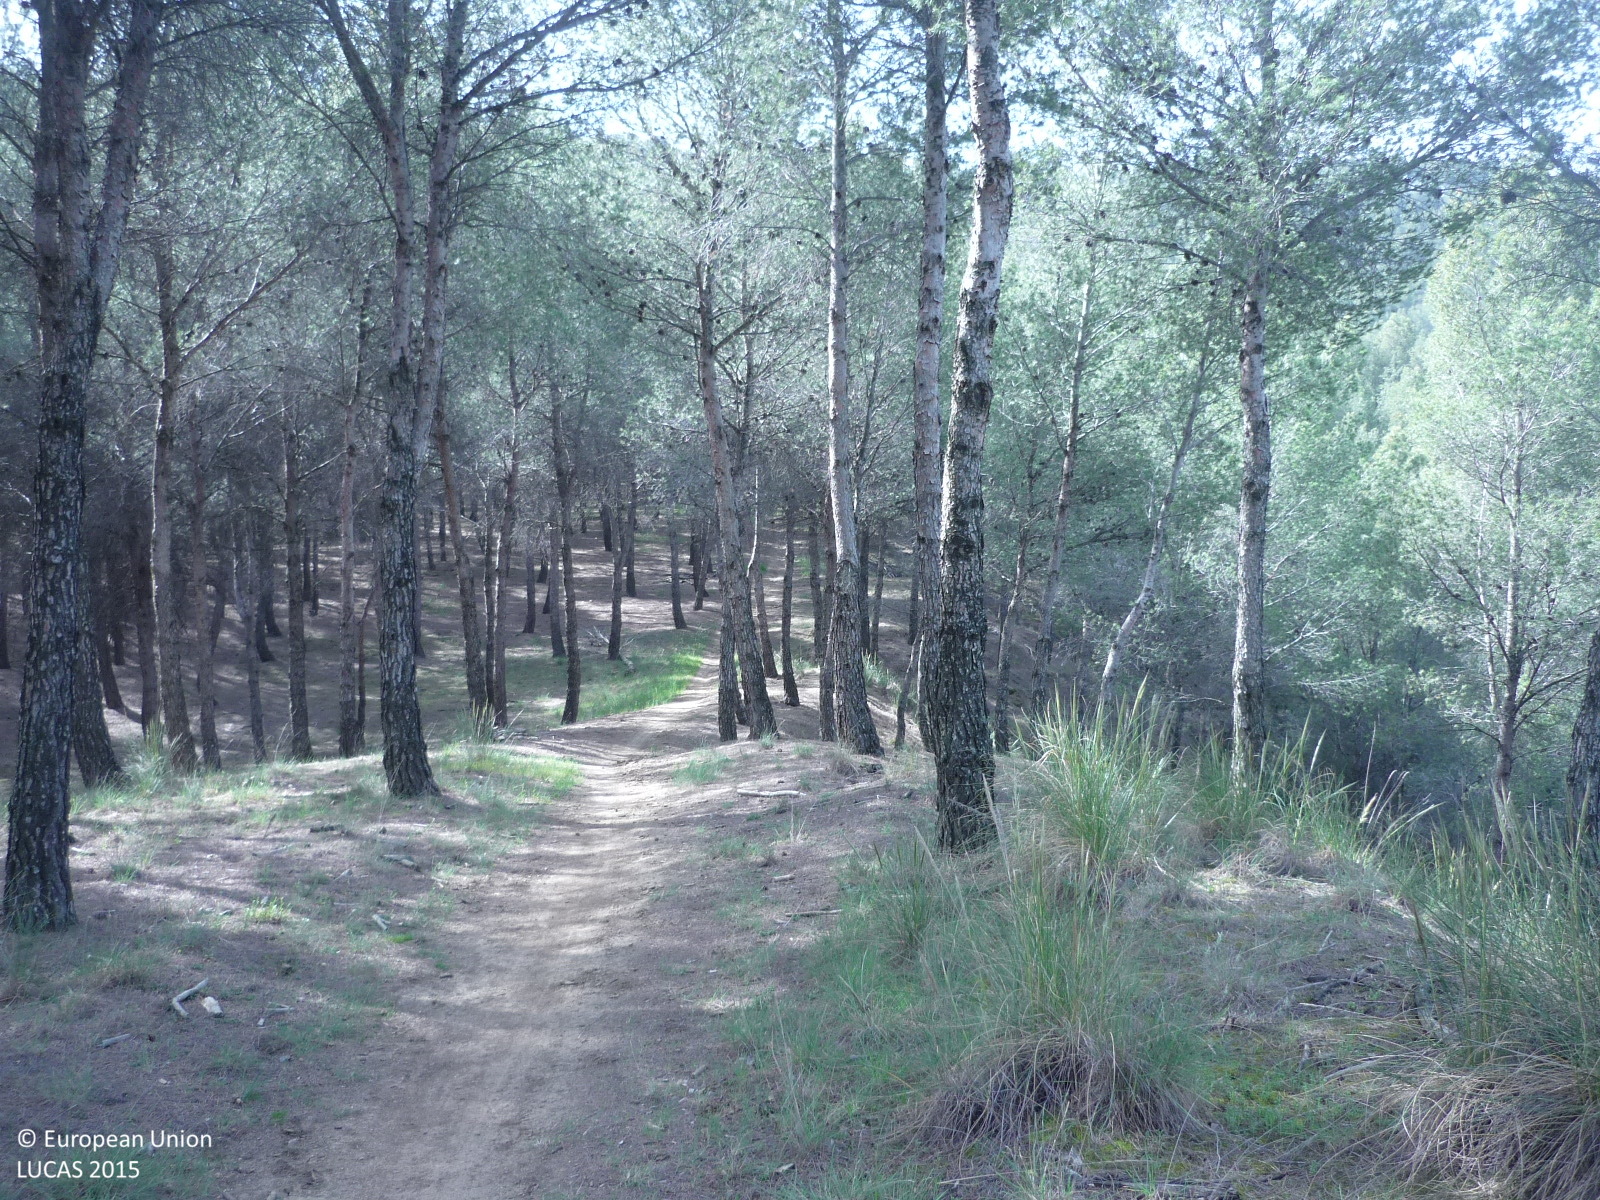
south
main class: Woodland
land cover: Pine dominated coniferous woodland
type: coniferous forest of the mediterranean region
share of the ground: > 75 %
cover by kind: coniferous forest trees 90 %, herbaceous plants 10 %
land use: Semi-natural and natural areas not in use
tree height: < 5 m
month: April
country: ES
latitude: 40.4610
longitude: -3.3955
